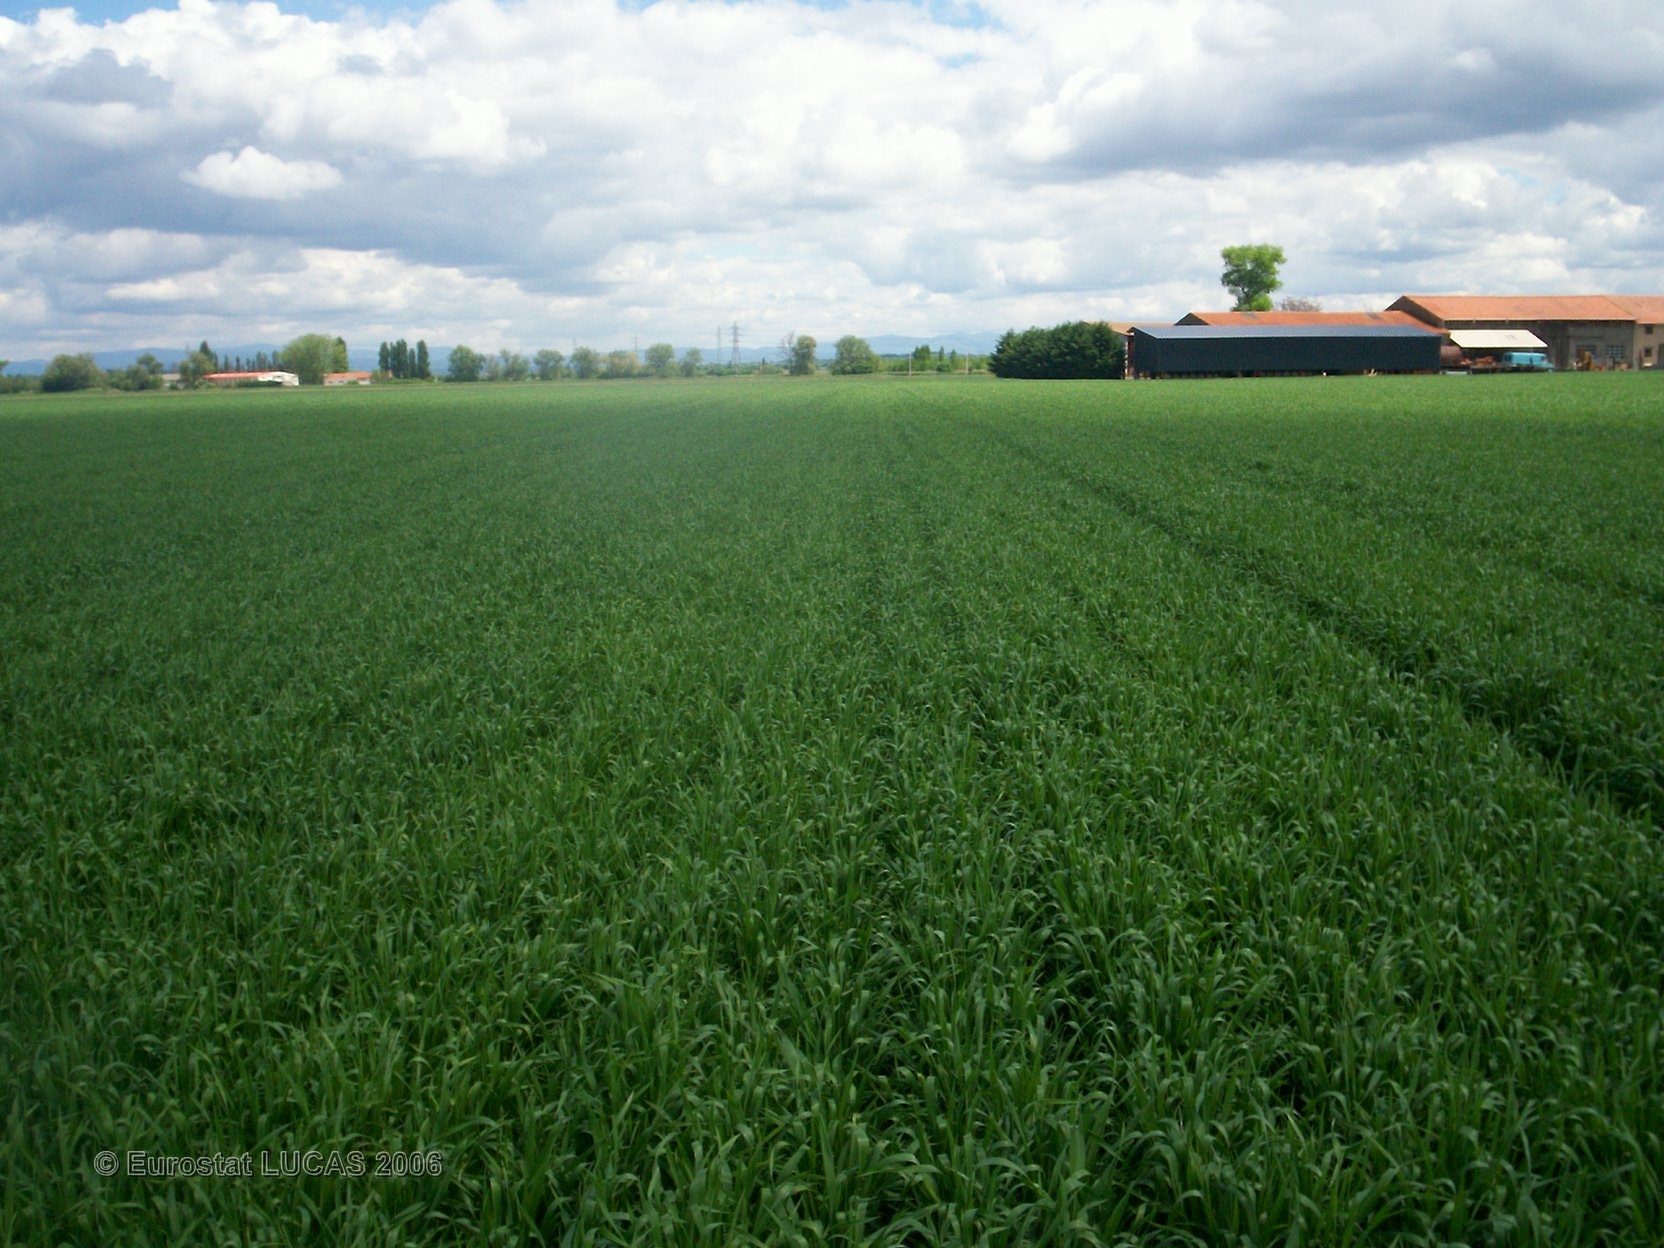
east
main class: Cropland
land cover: Common wheat
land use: Agriculture (excluding fallow land and kitchen gardens)
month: May
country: FR
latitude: 45.8268
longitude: 3.1904
